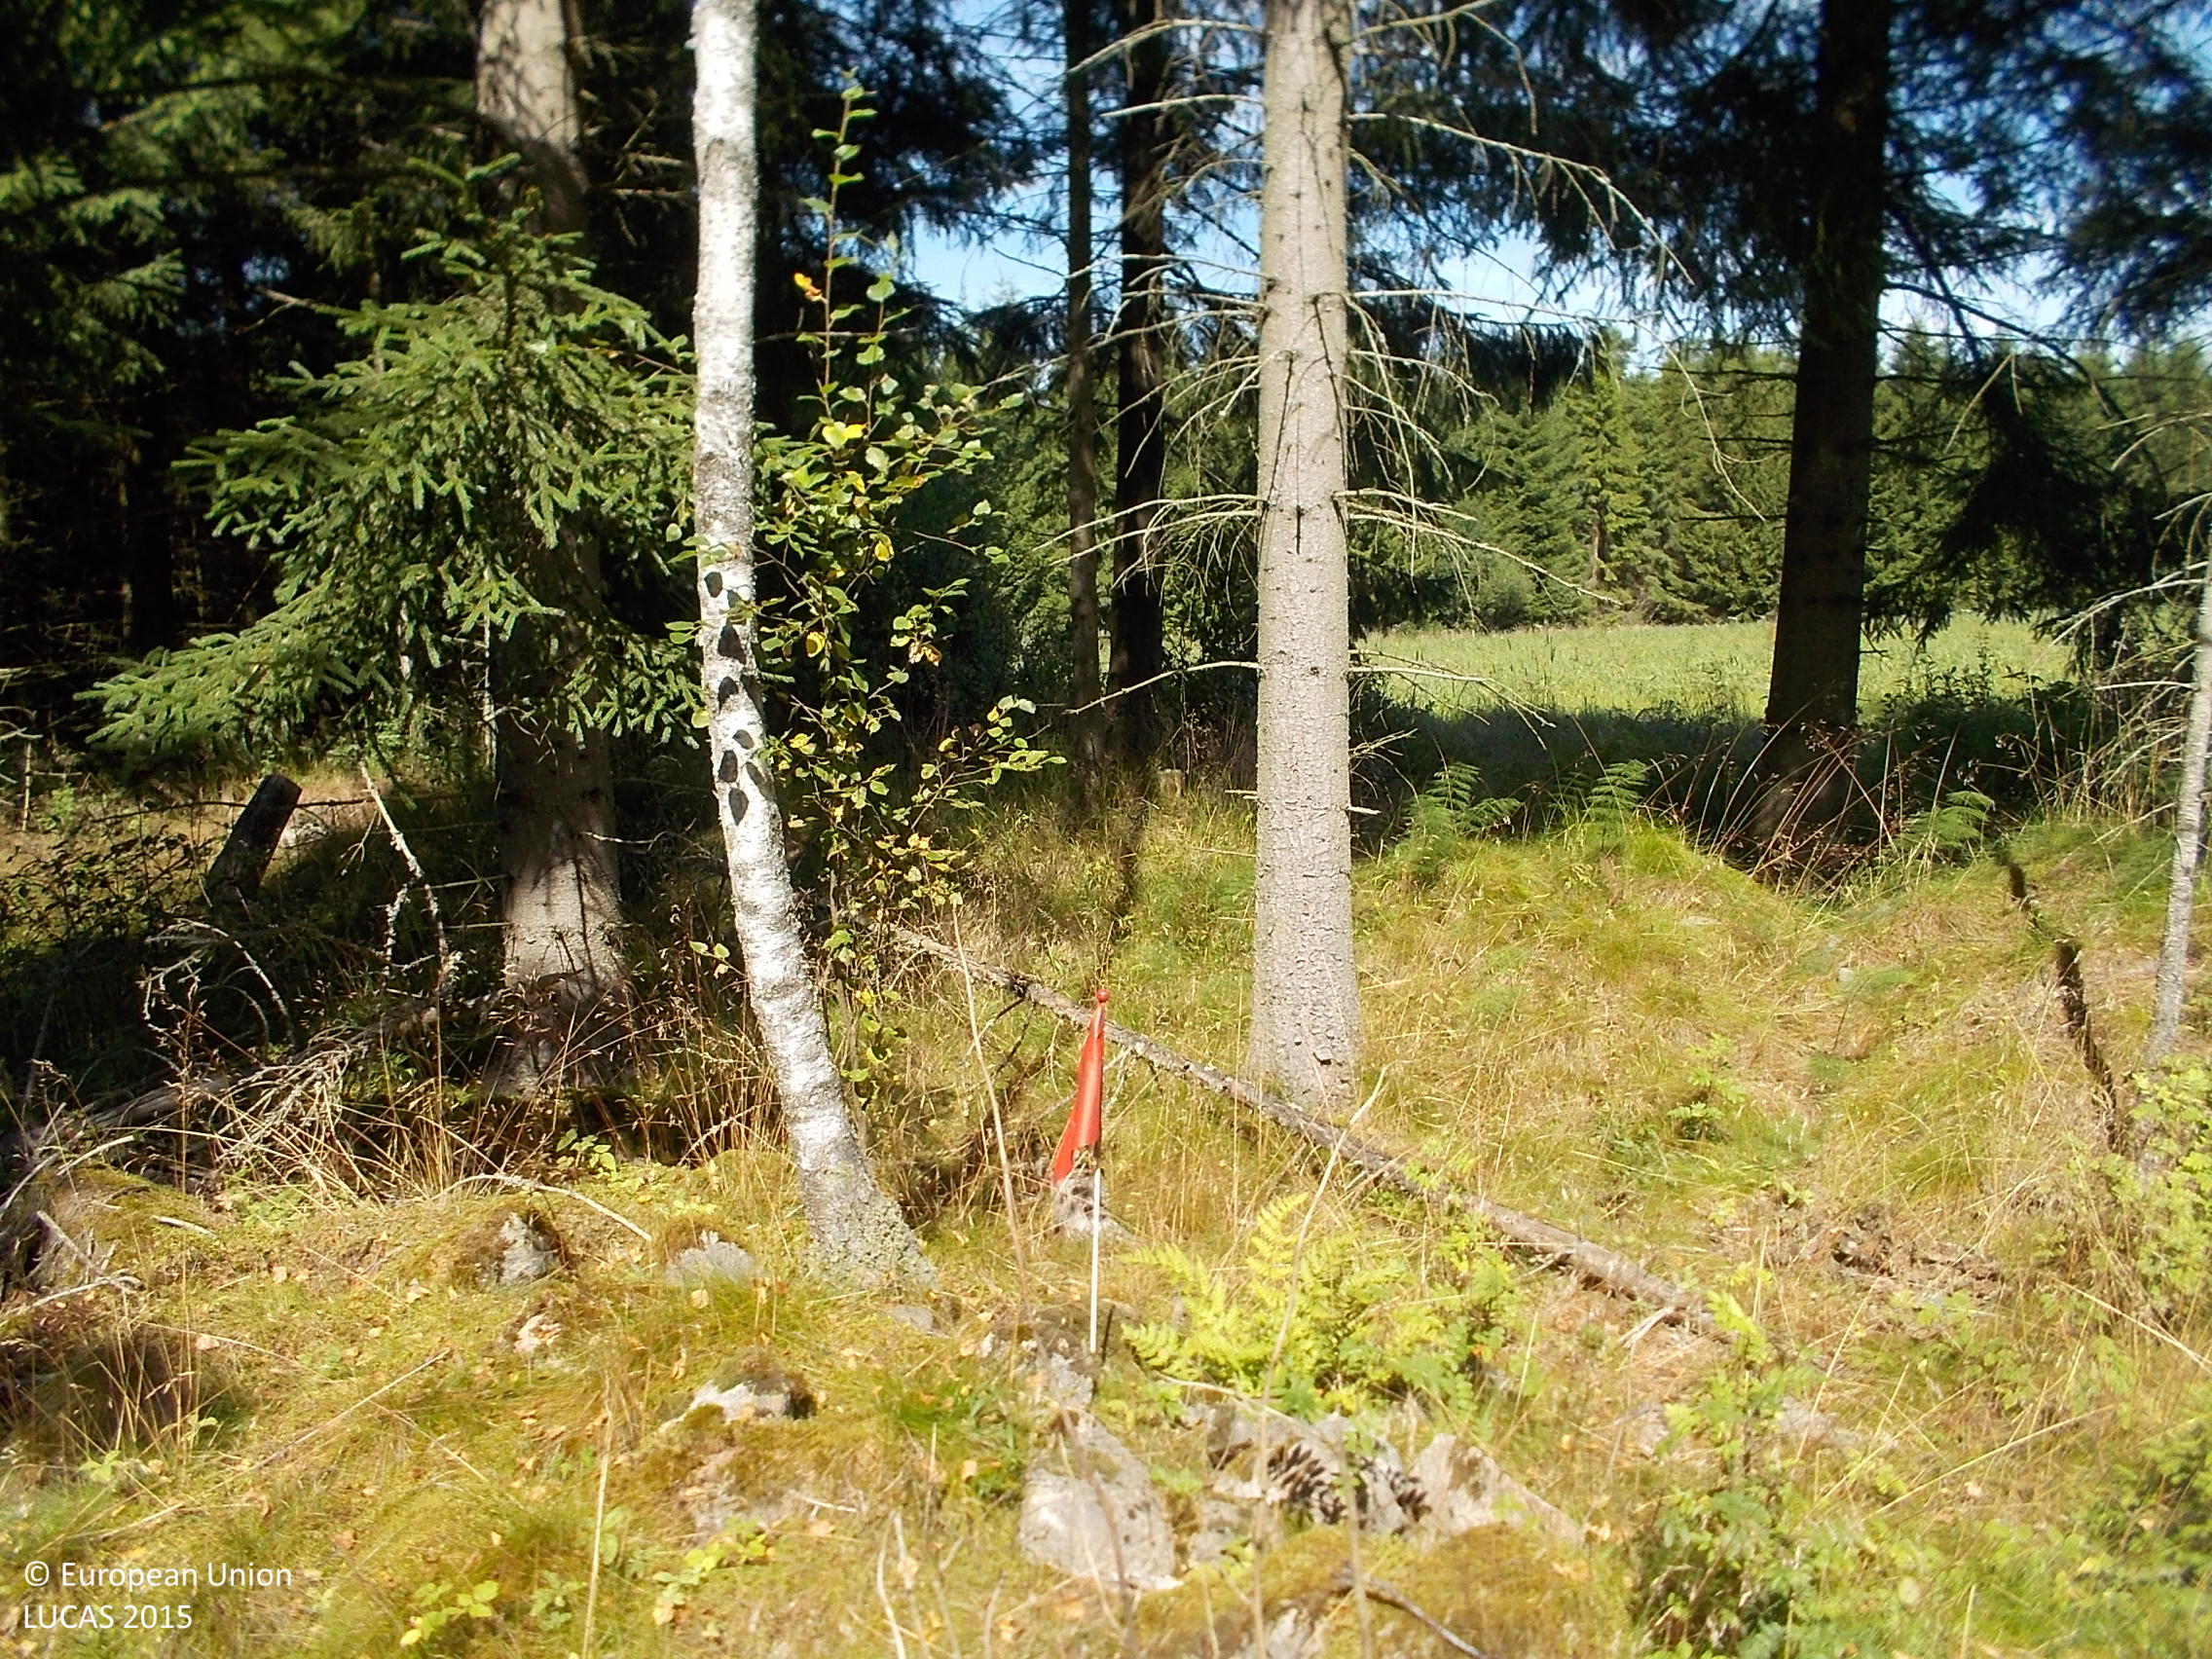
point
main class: Woodland
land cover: Spruce dominated coniferous woodland
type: boreal forest
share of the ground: > 75 %
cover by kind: coniferous forest trees 75 %, shrubs 10 %, herbaceous plants 10 %, lichens and mosses 5 %
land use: Forestry
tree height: > 5 m
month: August
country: SE
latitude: 57.5869
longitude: 13.2239
